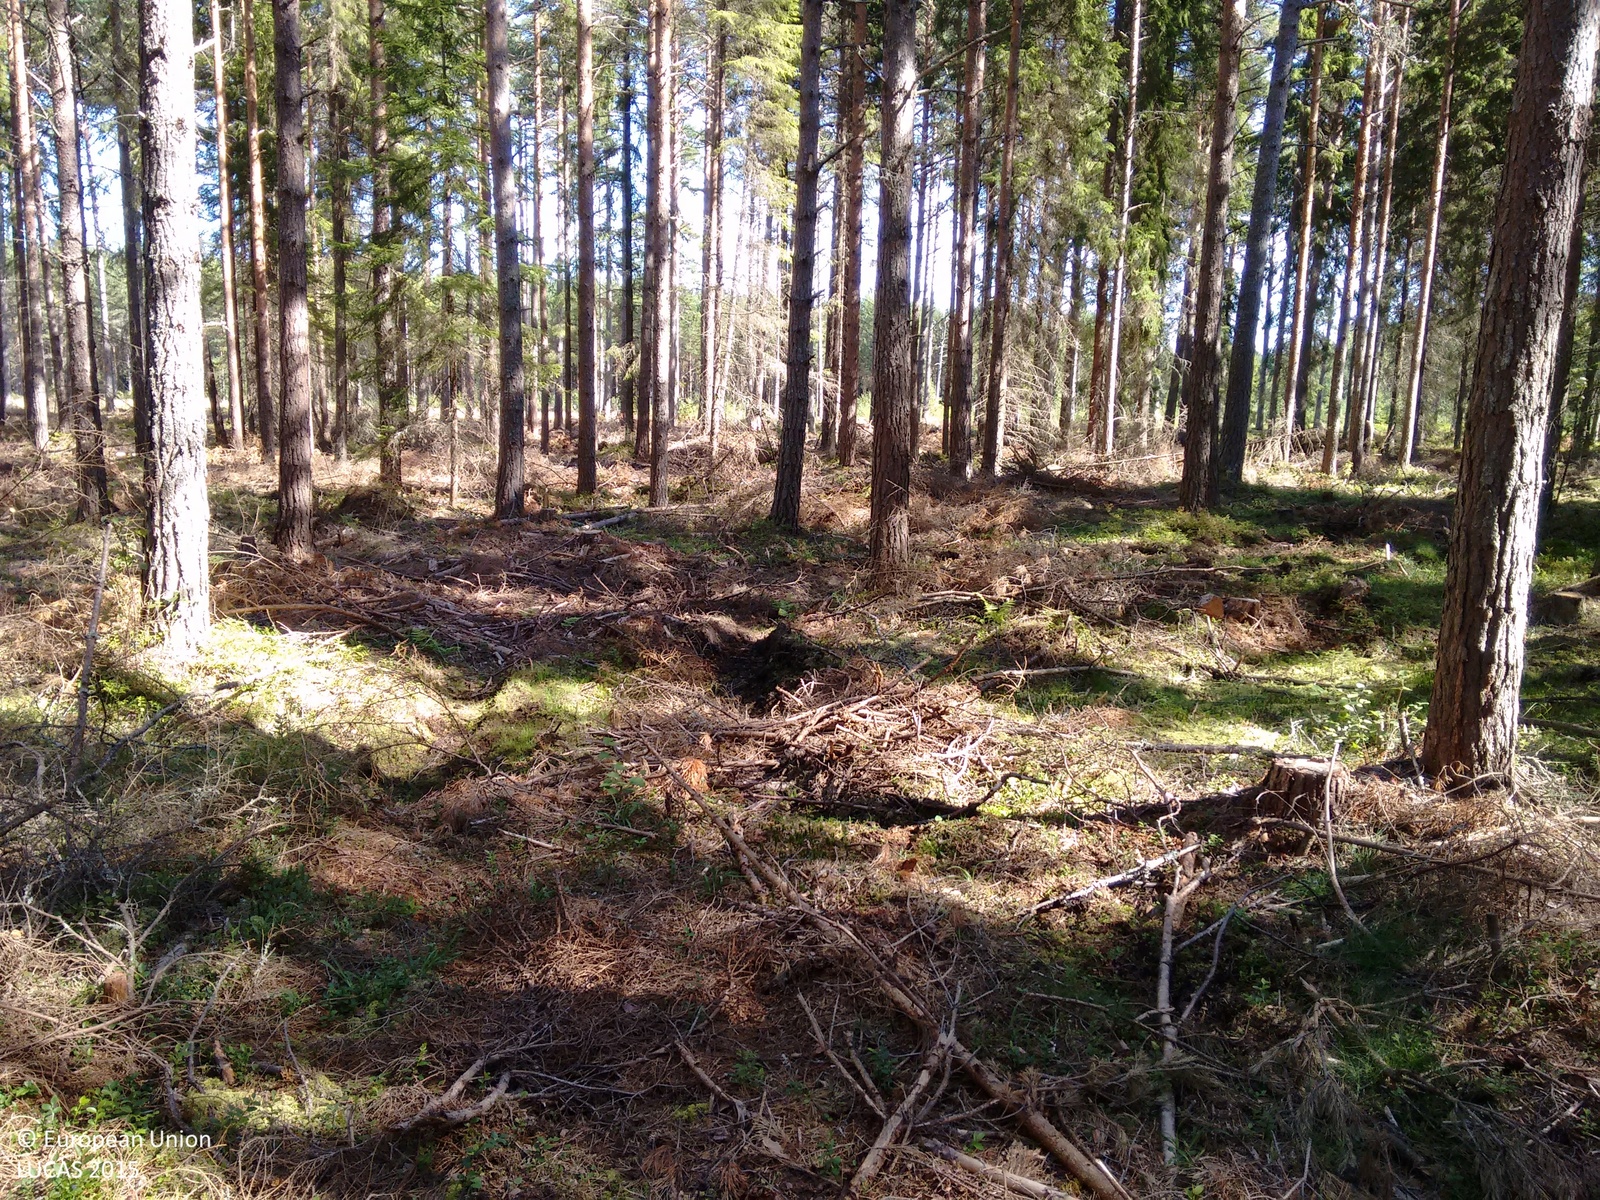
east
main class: Woodland
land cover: Pine dominated coniferous woodland
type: hemiboreal forest and nemoral coniferous forest and mixed broadleaved-coniferous forest
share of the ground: > 75 %
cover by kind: coniferous forest trees 80 %, shrubs 5 %, herbaceous plants 5 %, lichens and mosses 5 %
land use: Forestry
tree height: > 5 m
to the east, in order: Pine dominated coniferous woodland; Grassland with sparse tree/shrub cover; Abandoned hedges; Ditches and canals; Grass margins; Paved roads, cycling and walking lanes; Grassland with sparse tree/shrub cover; Pine dominated coniferous woodland; Ditches and canals; Grass margins; Tracks; Pine dominated coniferous woodland
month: August
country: FI
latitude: 60.2523
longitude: 19.5973
